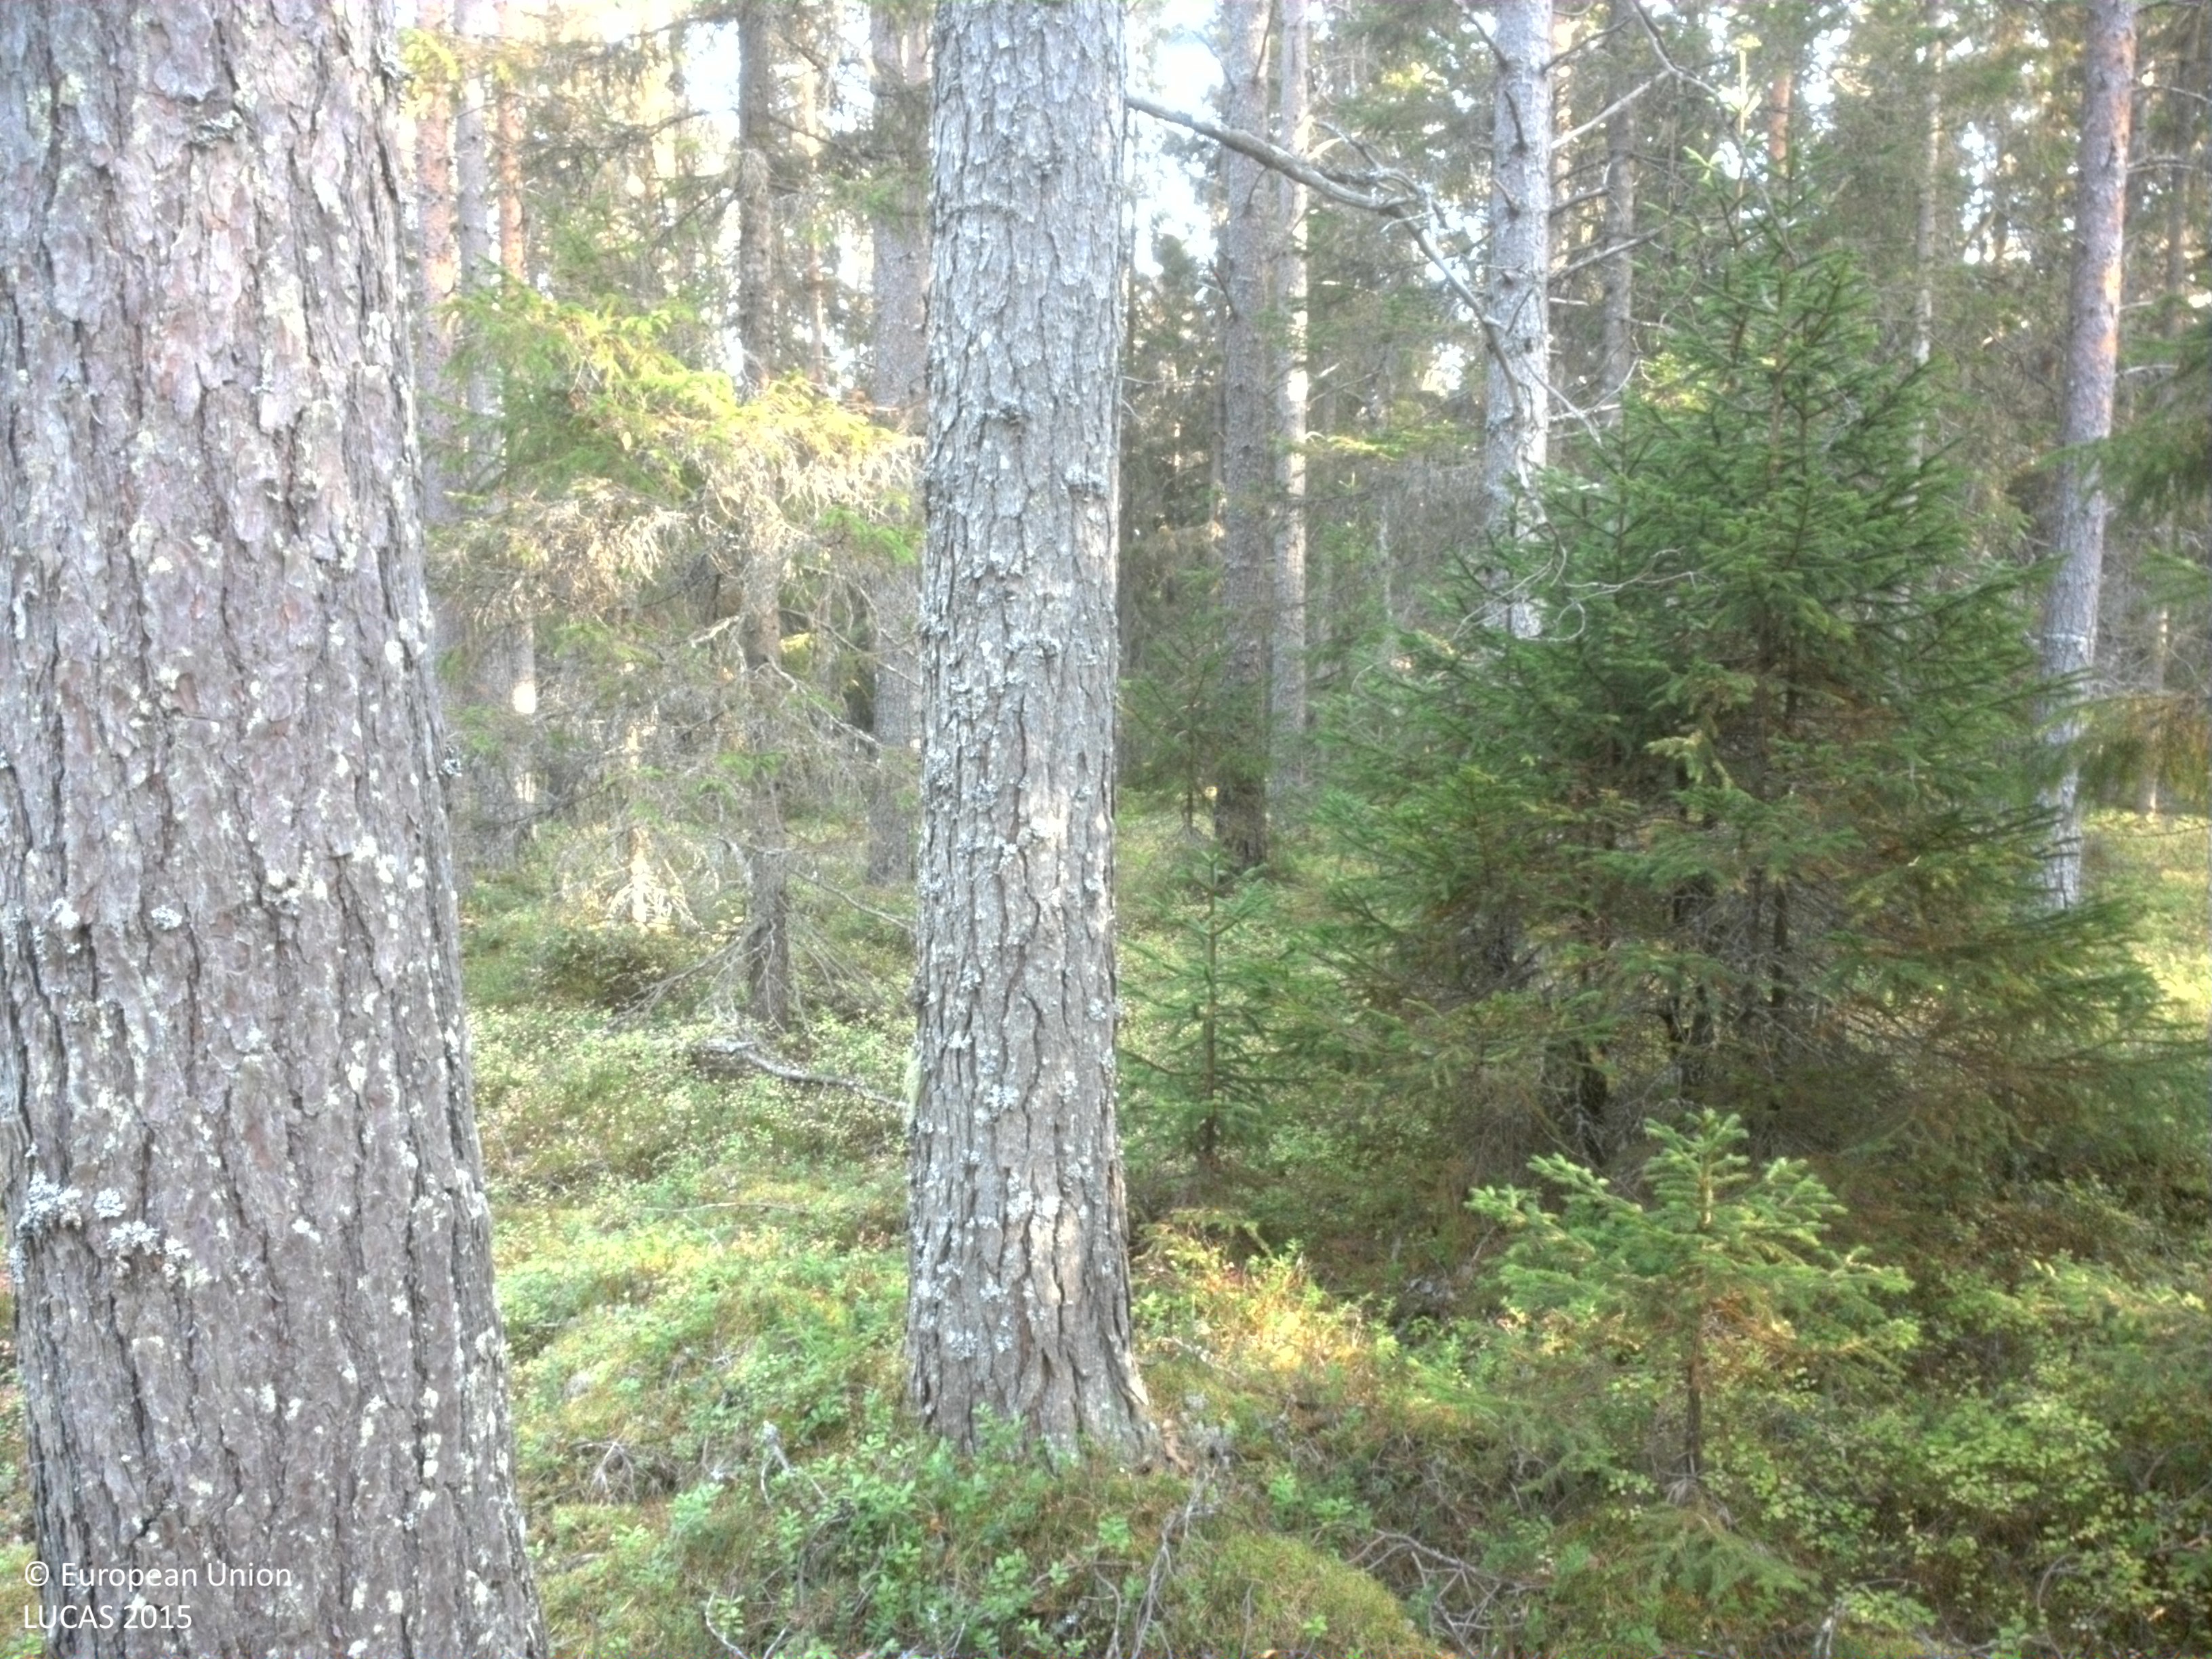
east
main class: Woodland
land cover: Other coniferous woodland
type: boreal forest
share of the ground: 50 - 75 %
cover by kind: coniferous forest trees 65 %, shrubs 30 %, lichens and mosses 5 %
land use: Forestry
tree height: > 5 m
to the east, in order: Other coniferous woodland; Spruce dominated coniferous woodland; Other coniferous woodland
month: October
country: SE
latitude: 63.8707
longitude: 20.7101
